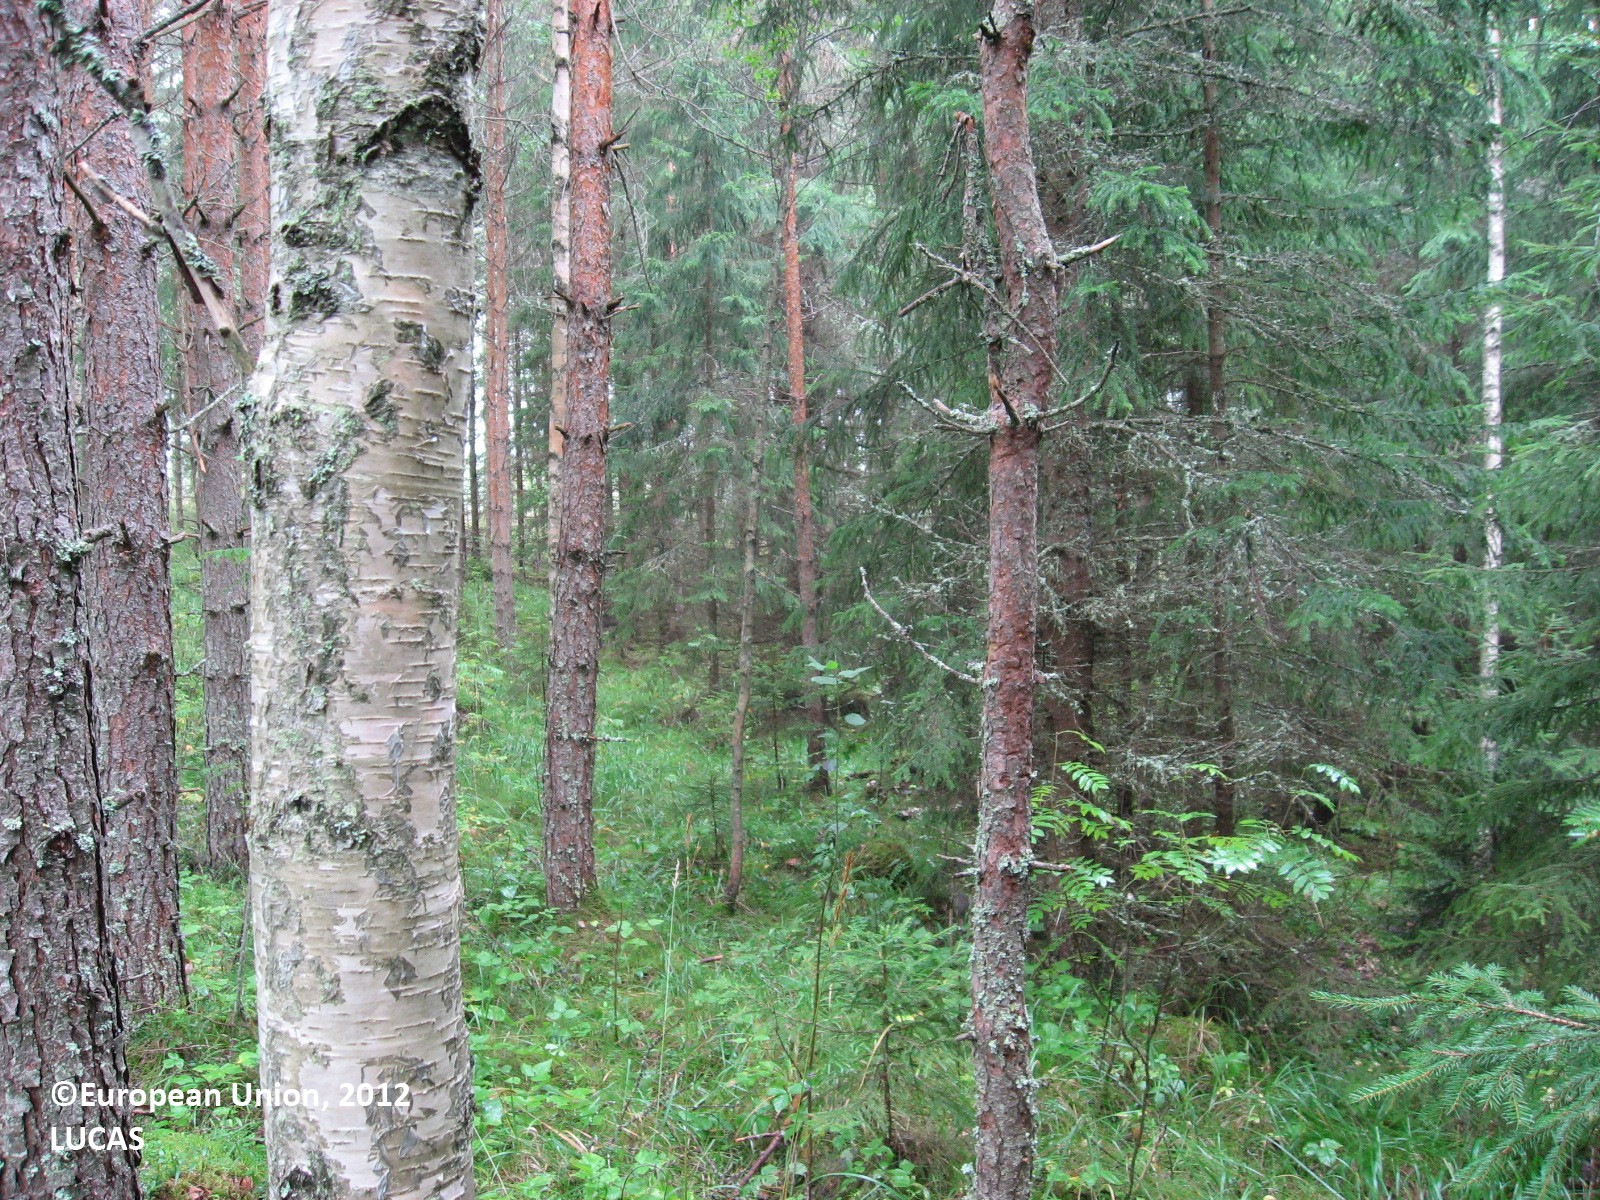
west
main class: Woodland
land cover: Pine dominated mixed woodland
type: boreal forest
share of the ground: 50 - 75 %
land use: Forestry
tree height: > 5 m
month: August
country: FI
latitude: 60.6305
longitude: 25.0890
